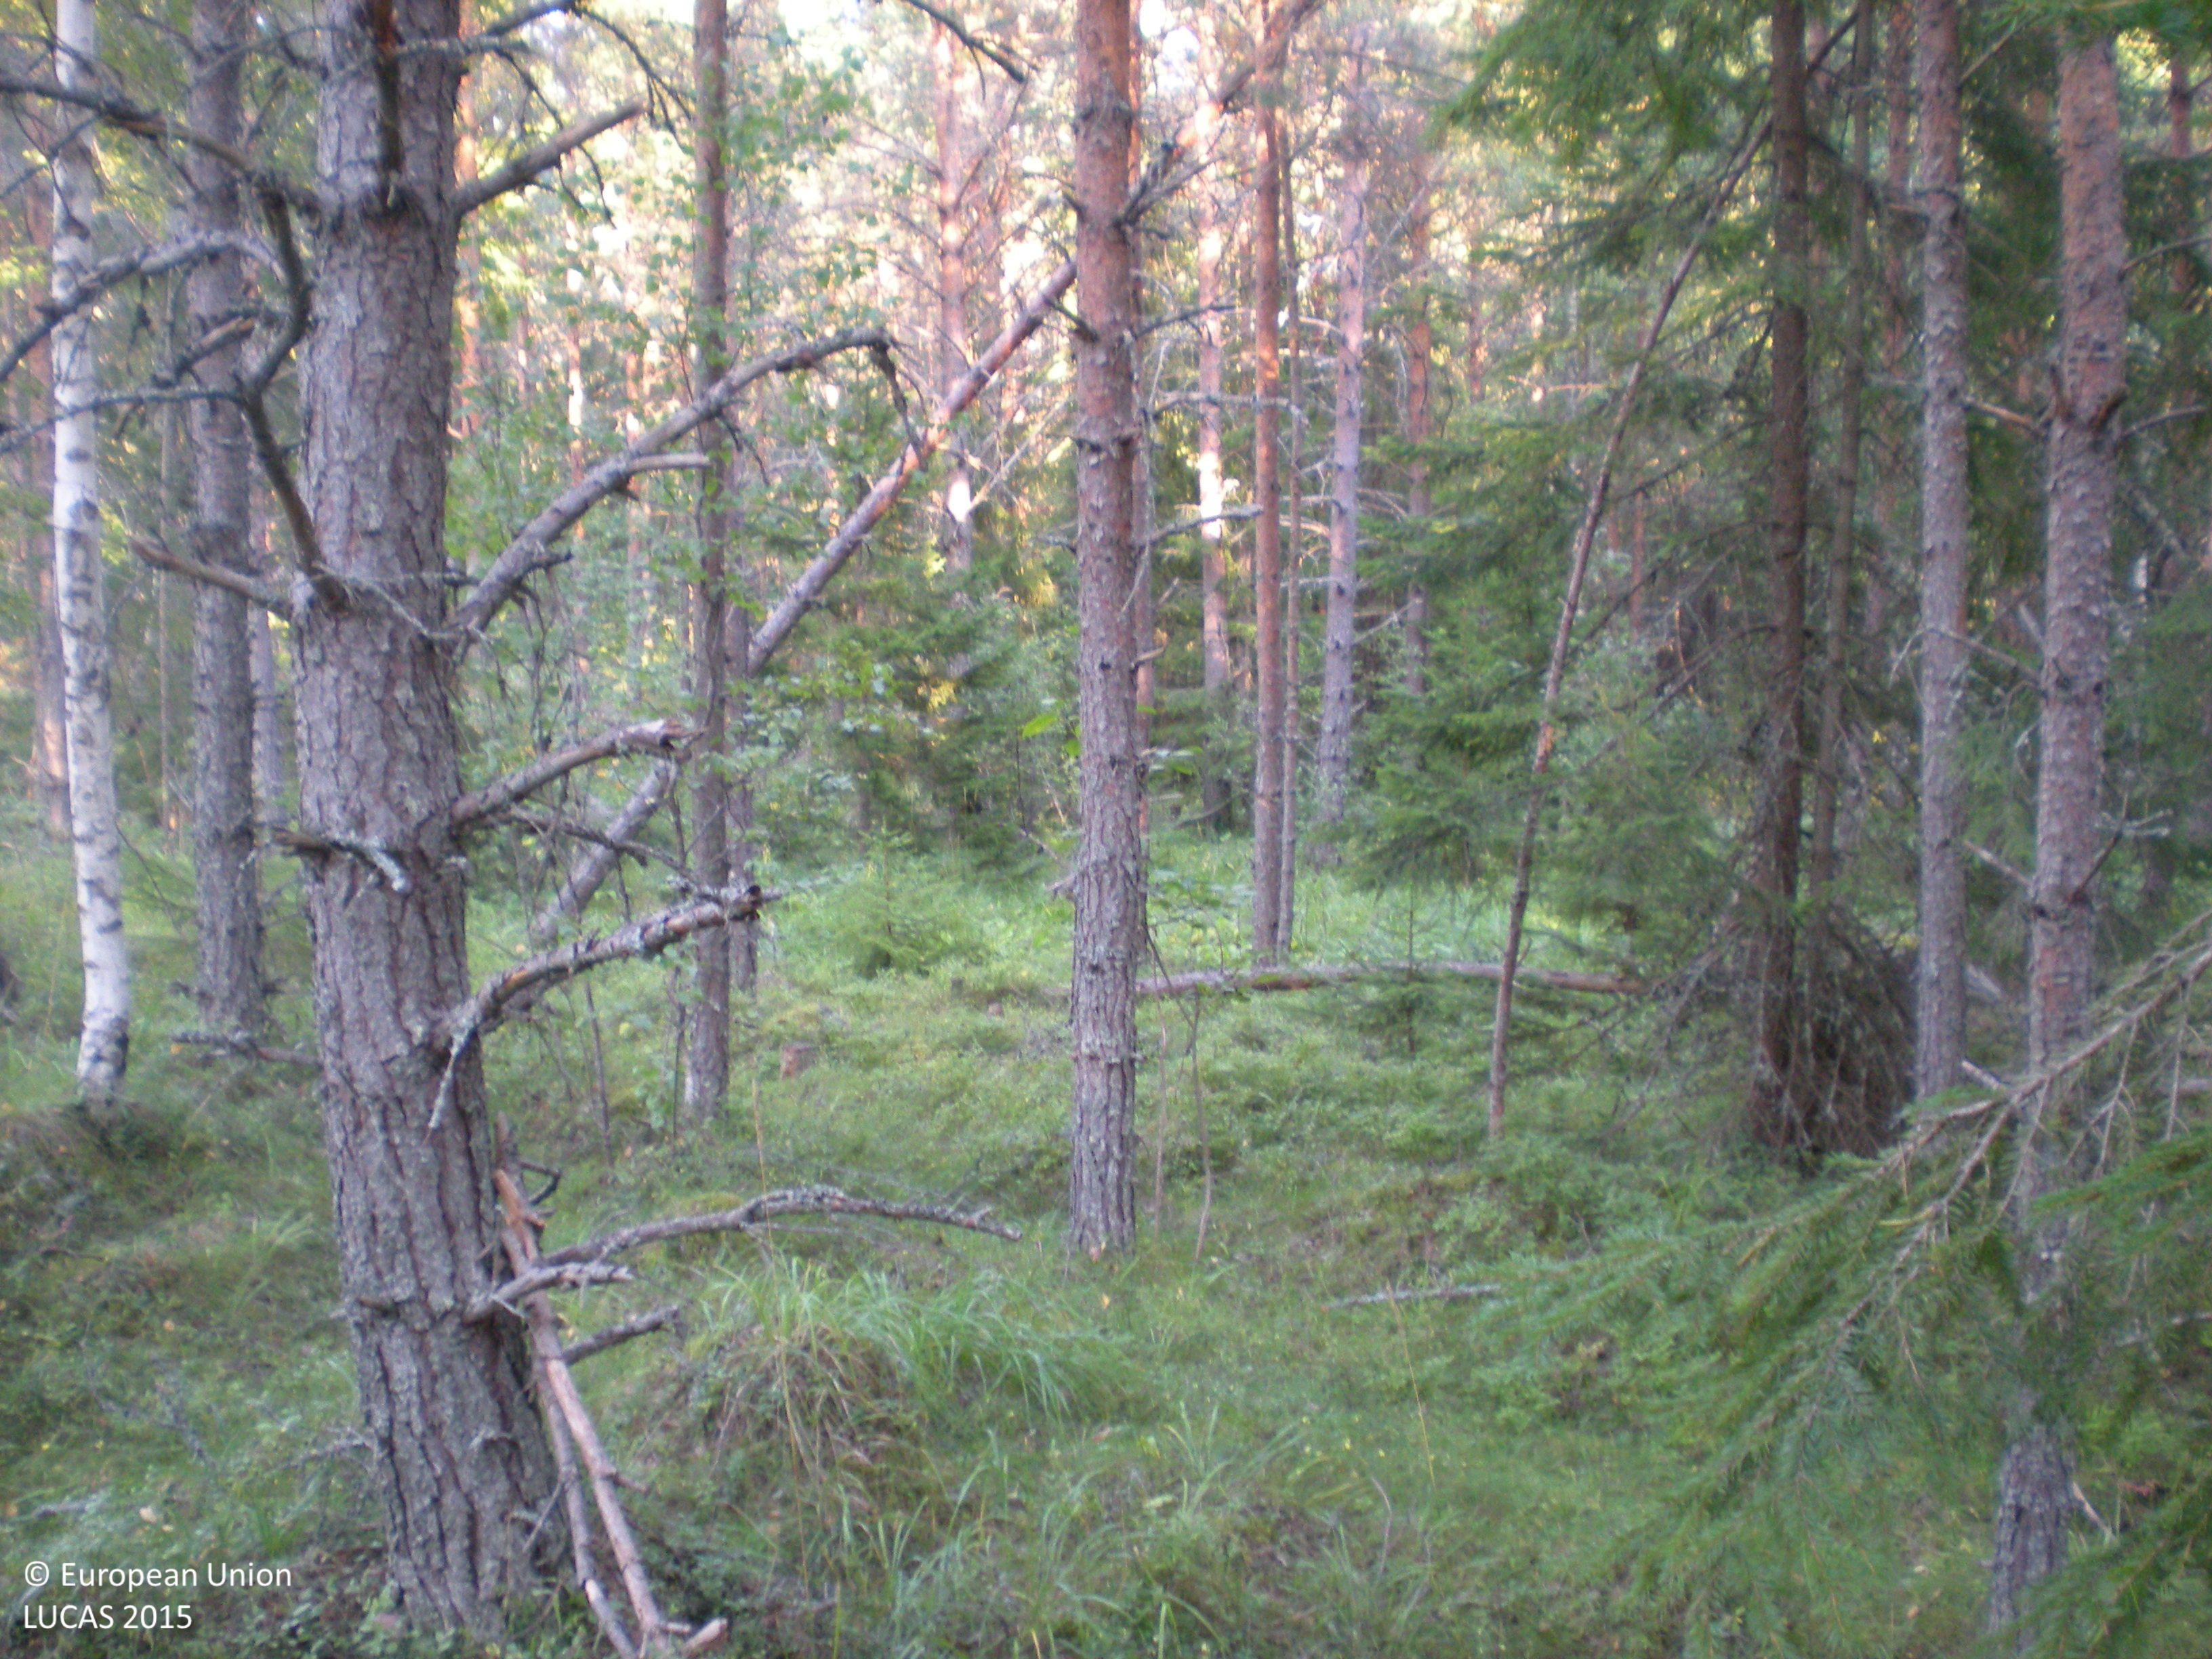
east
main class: Woodland
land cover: Pine dominated coniferous woodland
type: boreal forest
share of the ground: 50 - 75 %
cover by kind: coniferous forest trees 60 %, herbaceous plants 15 %, broadleaved forest trees 10 %, shrubs 10 %, lichens and mosses 5 %
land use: Forestry
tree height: > 5 m
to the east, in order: Pine dominated coniferous woodland; Other mixed woodland; Grassland without tree/shrub cover; Other coniferous woodland; Grassland with sparse tree/shrub cover; Other coniferous woodland
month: August
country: SE
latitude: 60.6059
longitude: 17.3141
